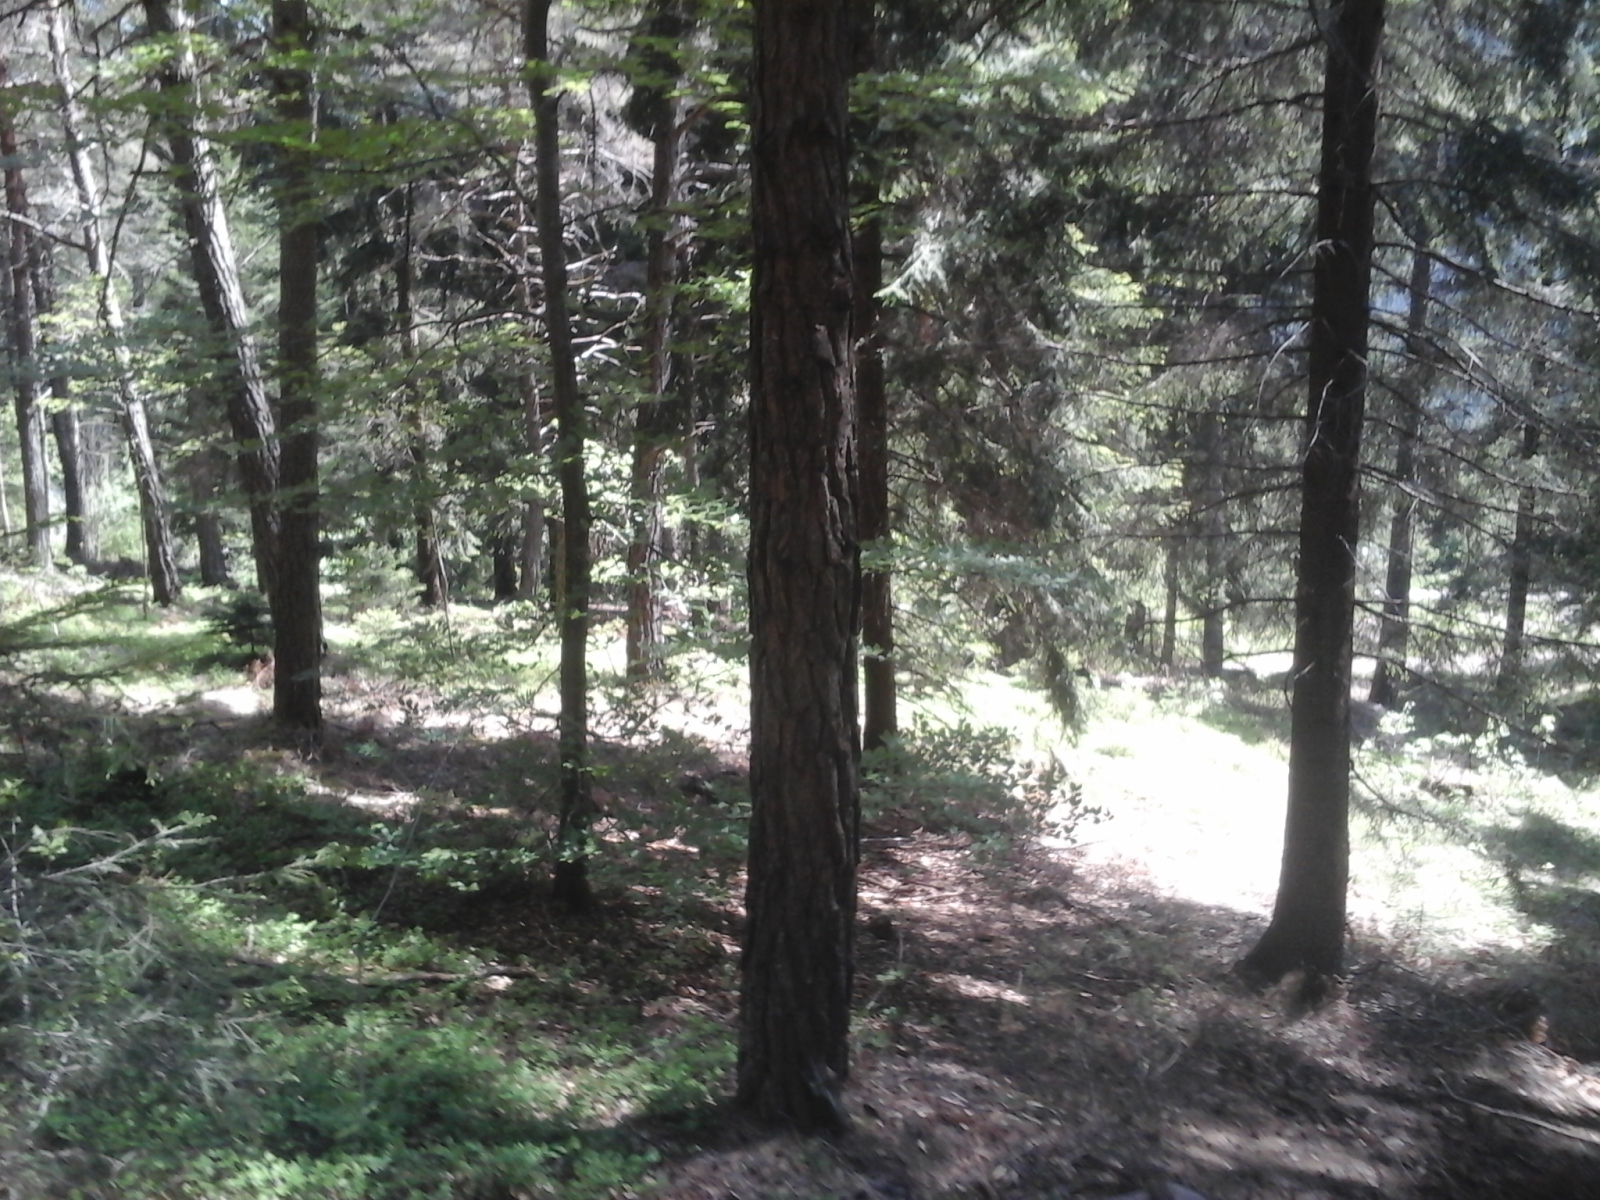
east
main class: Woodland
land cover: Pine dominated coniferous woodland
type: alpine coniferous forest
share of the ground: > 75 %
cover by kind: coniferous forest trees 90 %, broadleaved forest trees 5 %, herbaceous plants 5 %
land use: Forestry
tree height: > 5 m
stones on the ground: 10 - 25 %
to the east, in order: Pine dominated coniferous woodland; Tracks; Spruce dominated coniferous woodland; Paved roads, cycling and walking lanes; Spruce dominated coniferous woodland; Grass margins; Paved roads, cycling and walking lanes; Other bare soil; Artificial constructions in urban areas; Grassland with sparse tree/shrub cover; Other mixed woodland; Grassland without tree/shrub cover
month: May
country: IT
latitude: 46.1457
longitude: 11.2541
